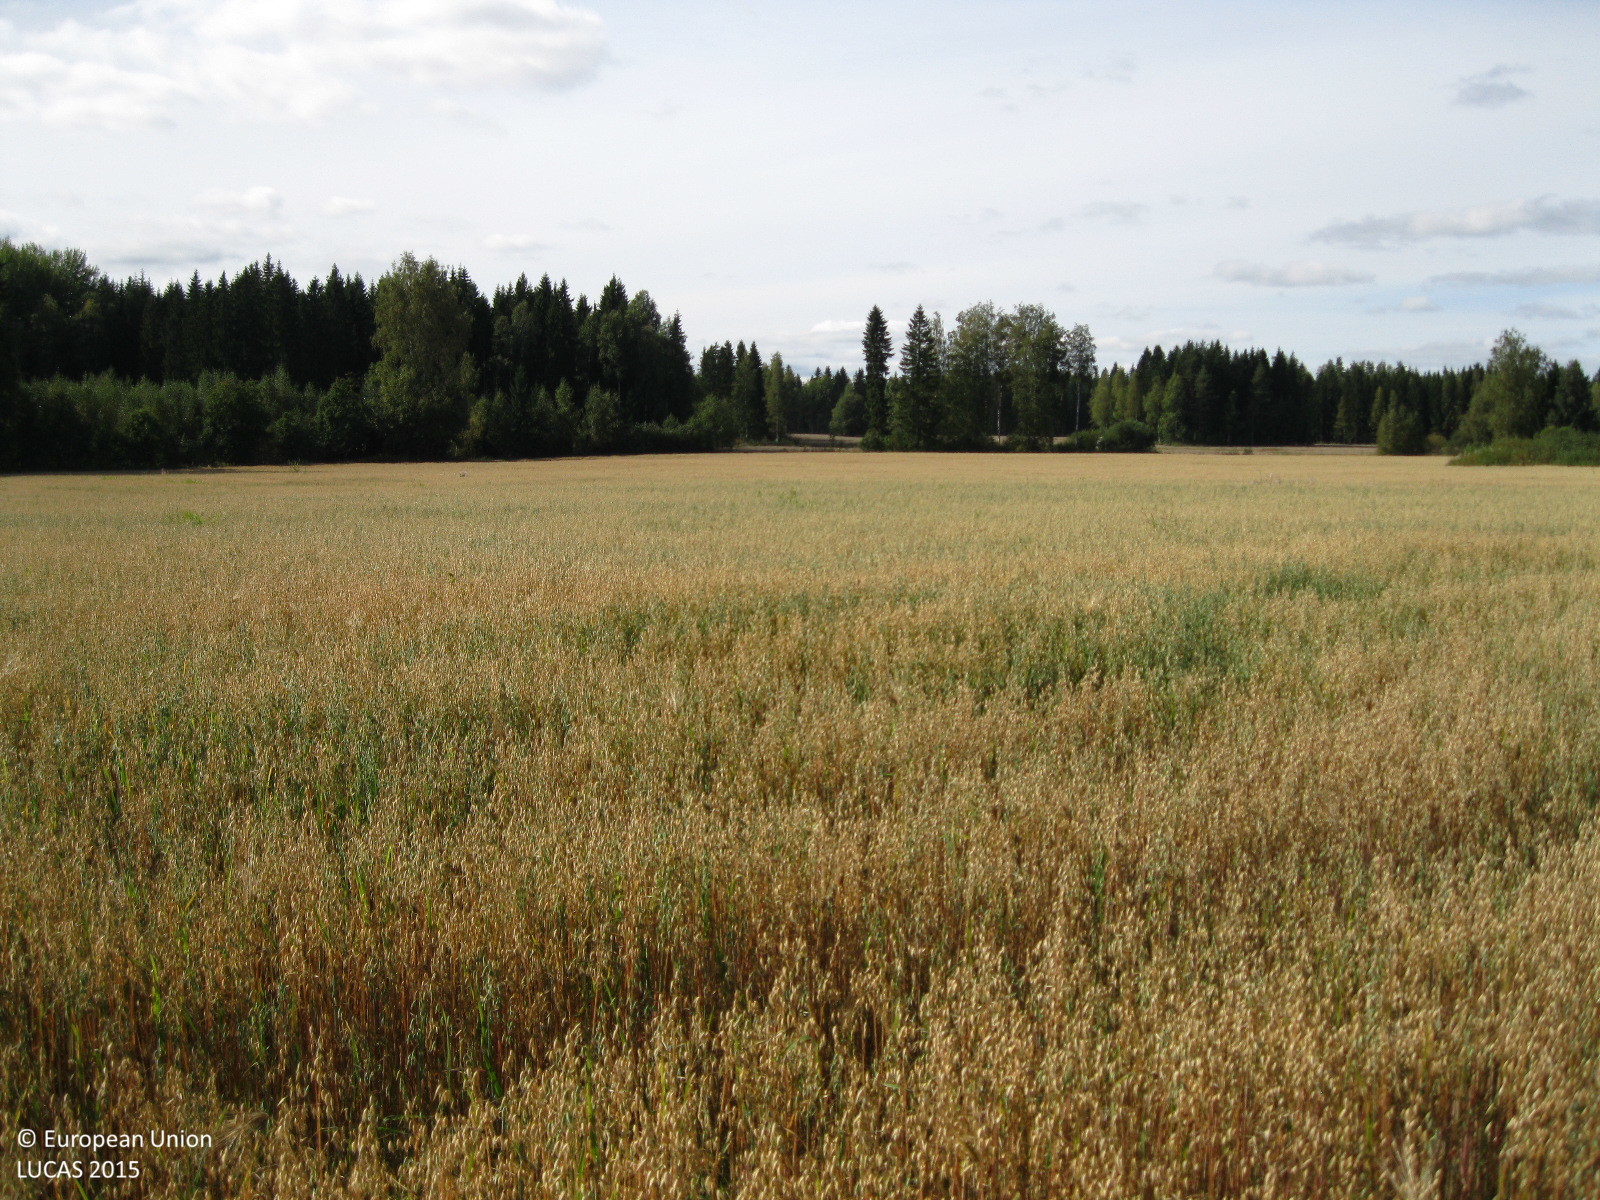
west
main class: Cropland
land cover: Oats
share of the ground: > 75 %
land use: Agriculture (excluding fallow land and kitchen gardens)
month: September
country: FI
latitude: 60.5499
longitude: 24.4548
